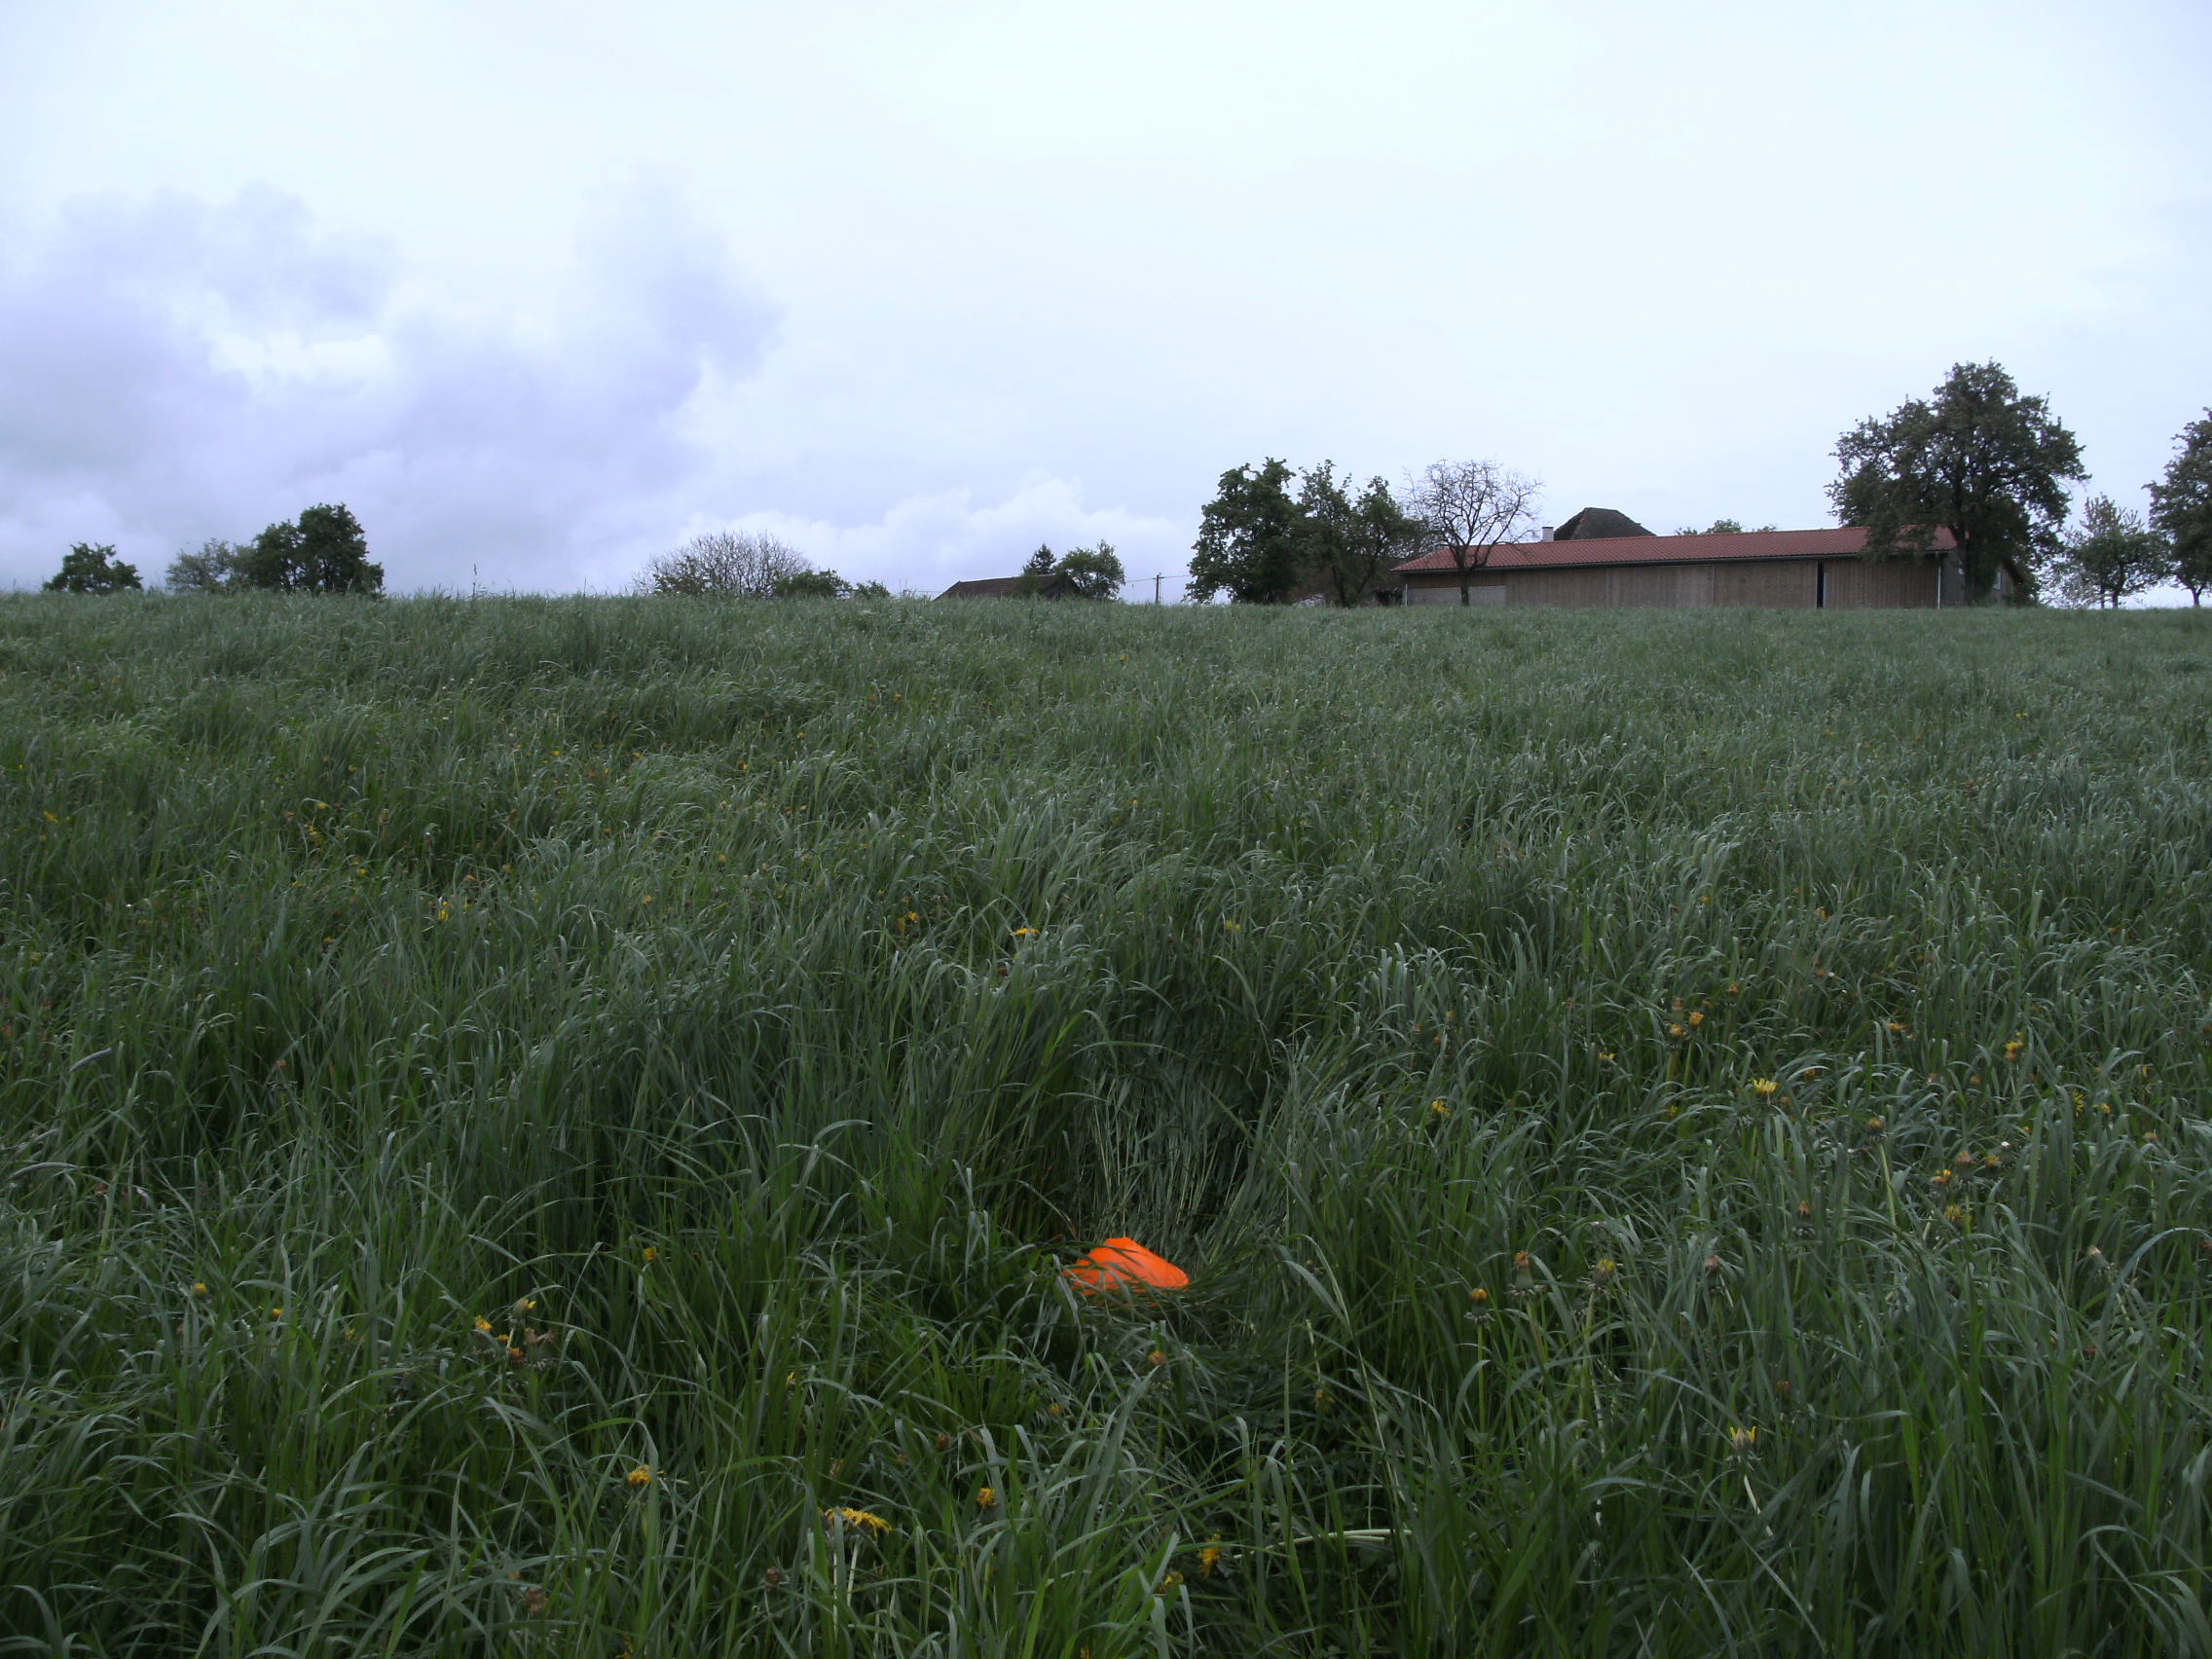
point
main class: Grassland
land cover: Grassland without tree/shrub cover
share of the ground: > 75 %
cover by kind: herbaceous plants 100 %
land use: Agriculture (excluding fallow land and kitchen gardens)
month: May
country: AT
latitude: 48.2585
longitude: 13.4880
